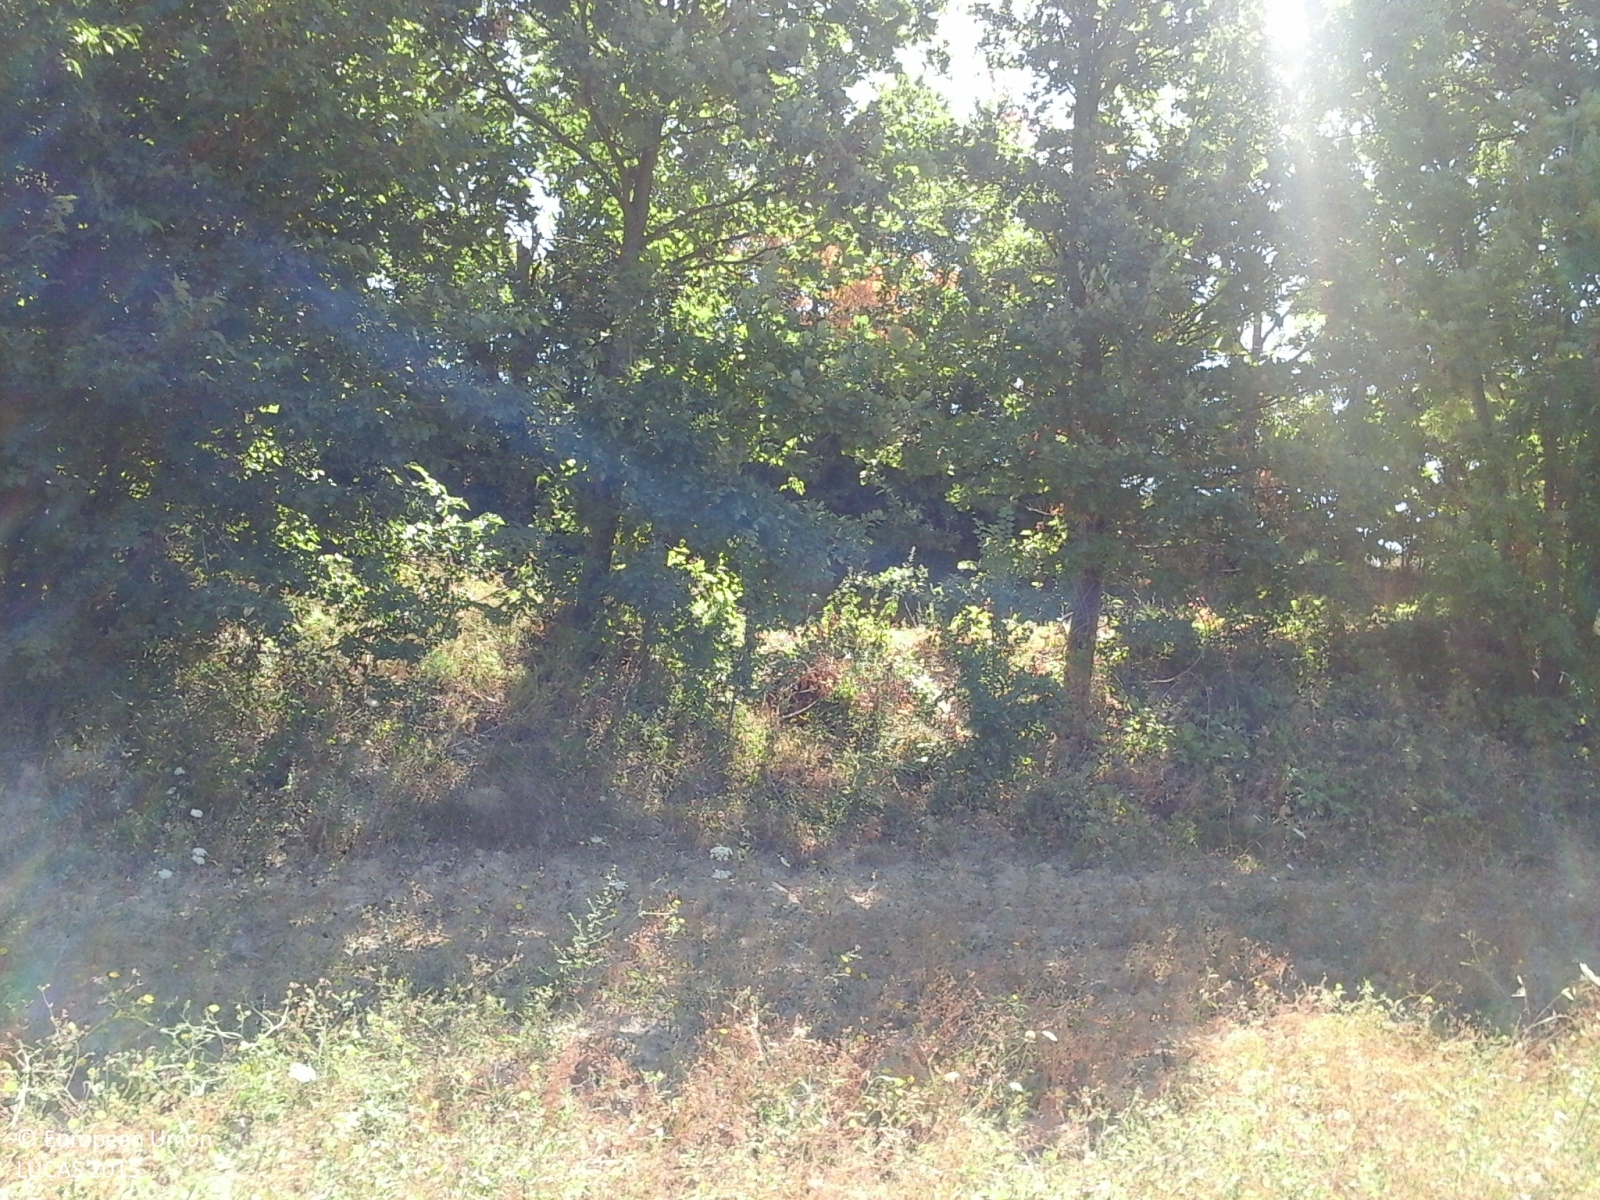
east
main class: Cropland
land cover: Other non-permanent industrial crops
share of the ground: > 75 %
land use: Agriculture (excluding fallow land and kitchen gardens)
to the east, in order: Other non-permanent industrial crops; Abandoned hedges; Electric lines; Grass margins; Tracks; Grass margins; Abandoned hedges; Lucerne; Rye; Nuts trees; Lucerne; Managed hedges
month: July
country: IT
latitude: 43.8470
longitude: 12.6680
